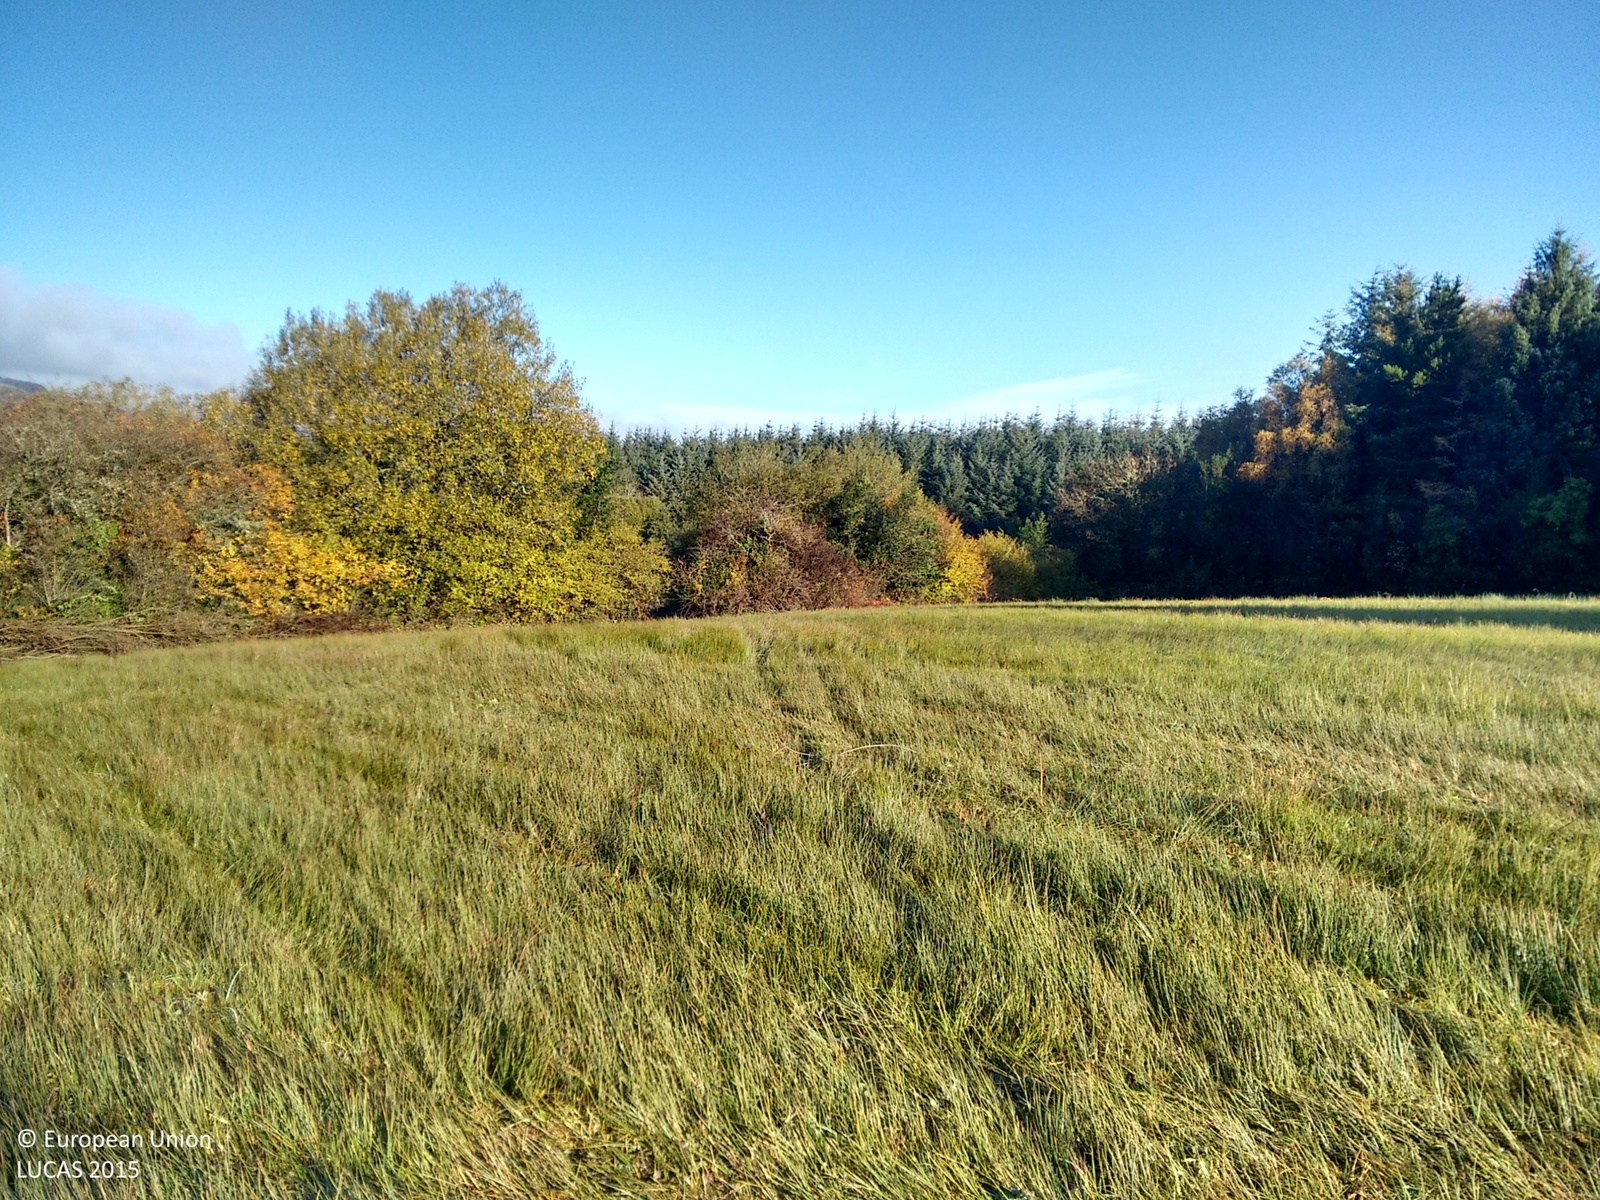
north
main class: Grassland
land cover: Grassland without tree/shrub cover
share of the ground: > 75 %
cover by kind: herbaceous plants 100 %
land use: Agriculture (excluding fallow land and kitchen gardens)
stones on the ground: < 10 %
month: October
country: IE
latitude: 54.0526
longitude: -8.0949
